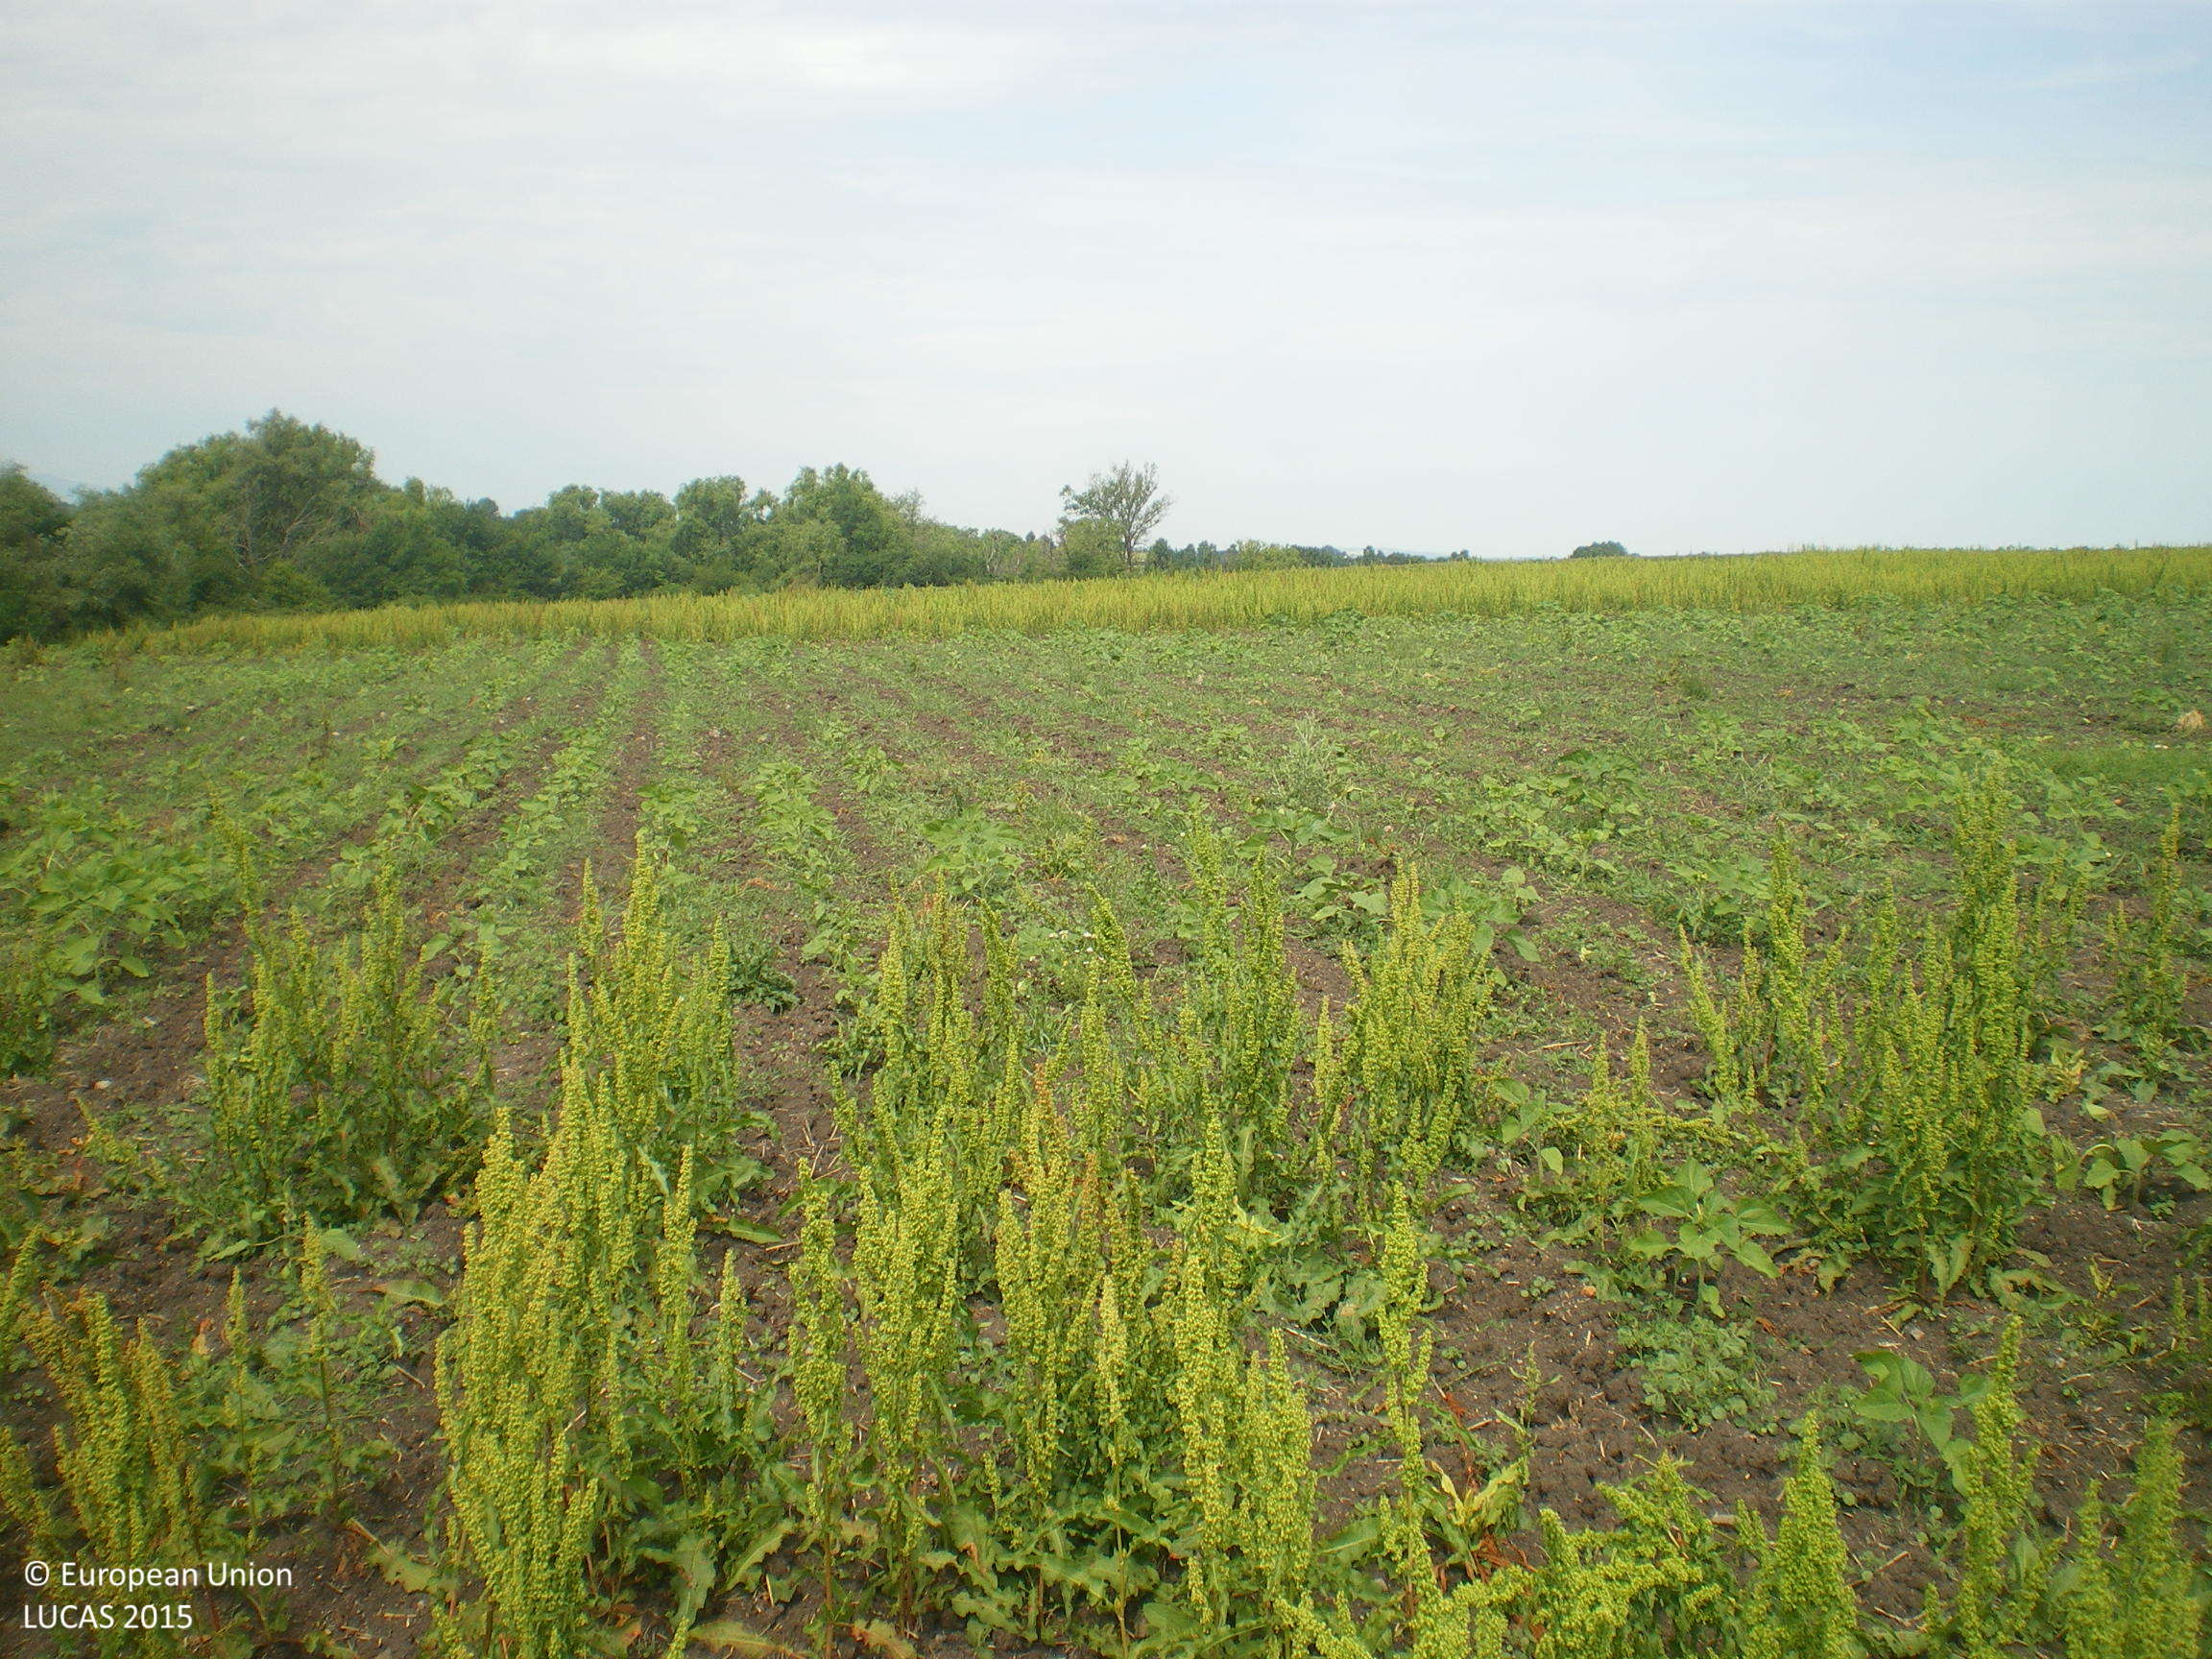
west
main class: Grassland
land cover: Spontaneously vegetated surfaces
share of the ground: > 75 %
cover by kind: herbaceous plants 100 %
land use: Fallow land
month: June
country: BG
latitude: 42.0383
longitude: 25.3919
